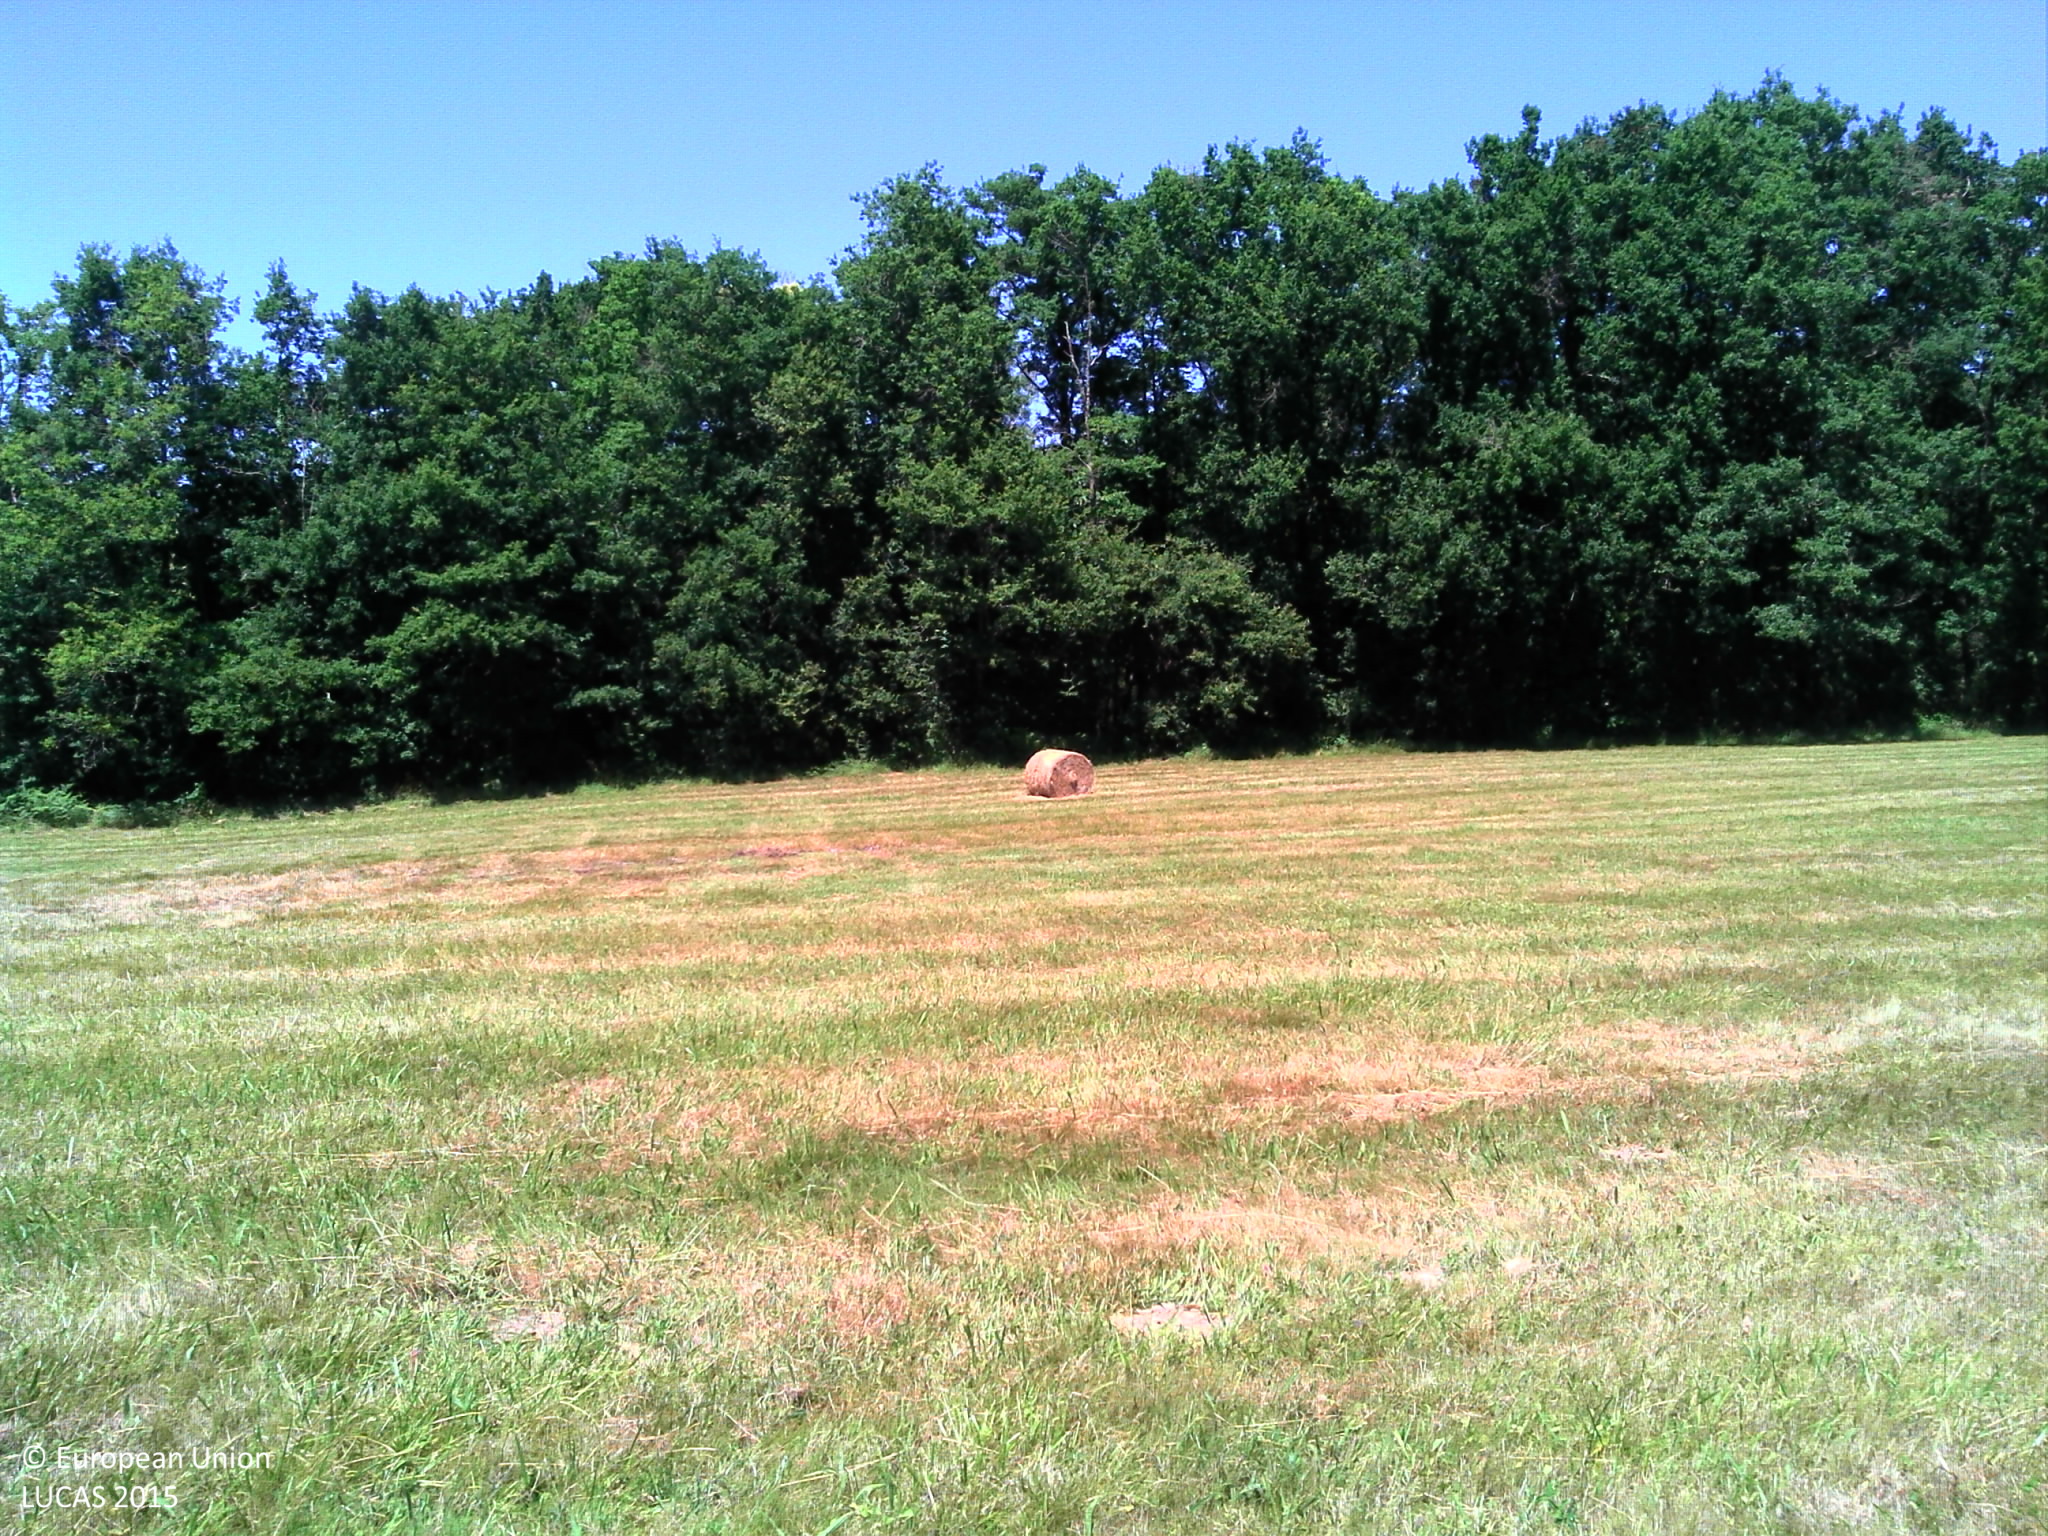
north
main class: Grassland
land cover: Grassland without tree/shrub cover
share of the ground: > 75 %
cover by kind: herbaceous plants 100 %
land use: Agriculture (excluding fallow land and kitchen gardens)
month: June
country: FR
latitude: 45.7811
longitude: 0.6880
